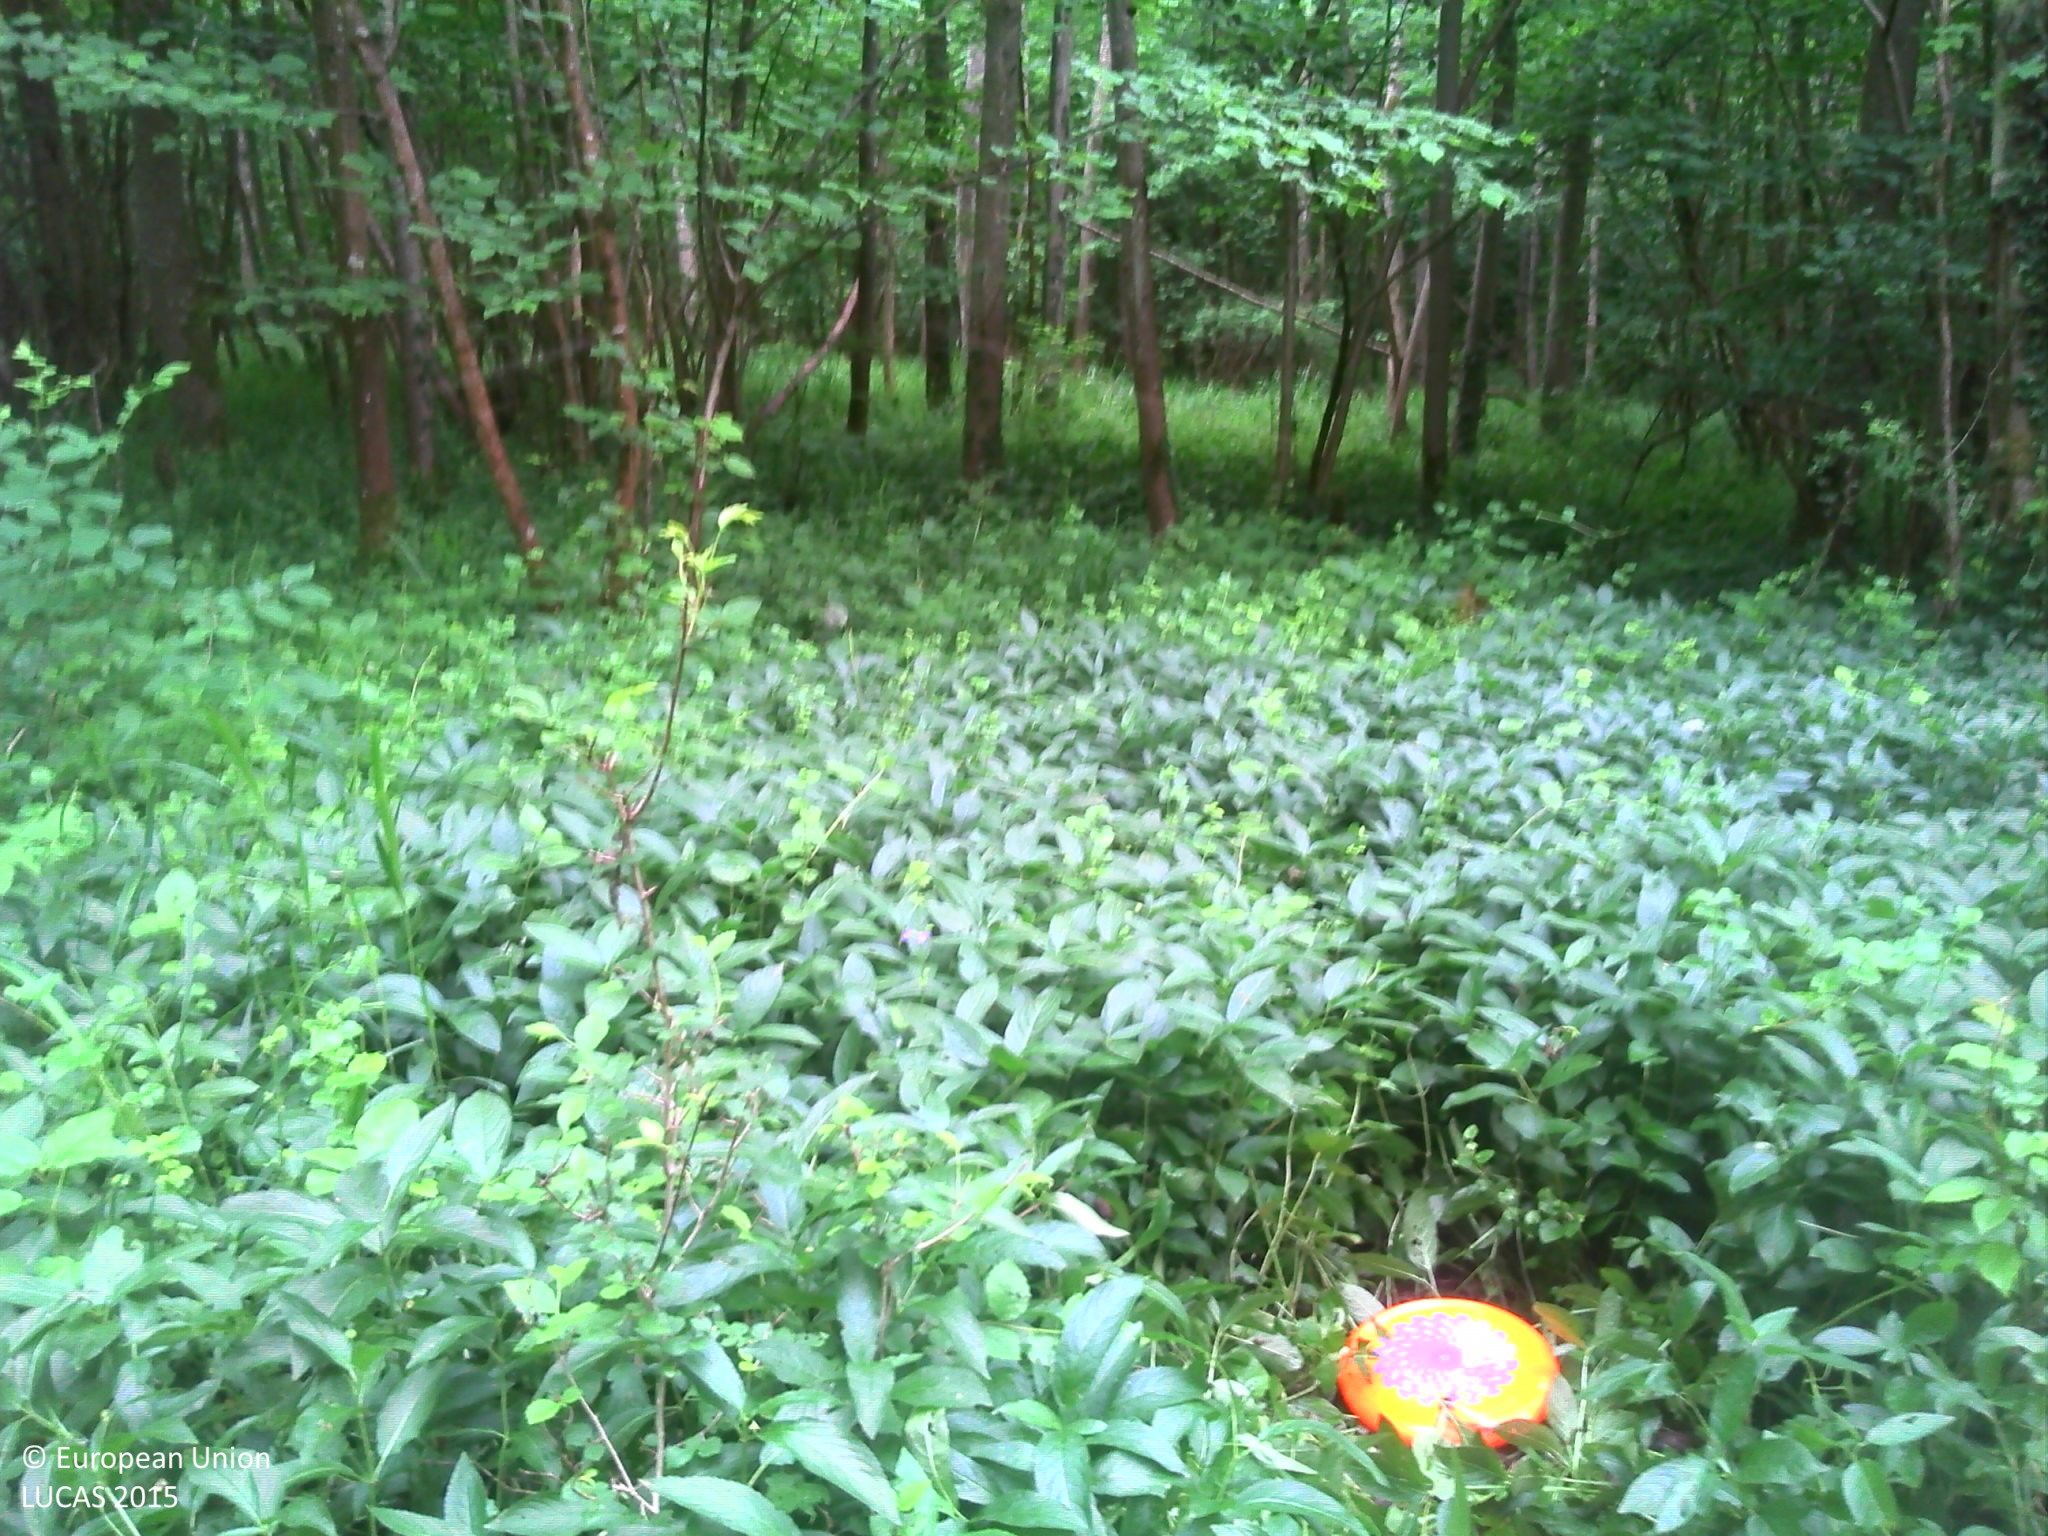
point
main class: Woodland
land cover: Broadleaved woodland
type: mesophytic deciduous forest
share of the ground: > 75 %
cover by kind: broadleaved forest trees 90 %, herbaceous plants 10 %
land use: Forestry
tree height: > 5 m
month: May
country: FR
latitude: 48.3226
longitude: 7.5599
